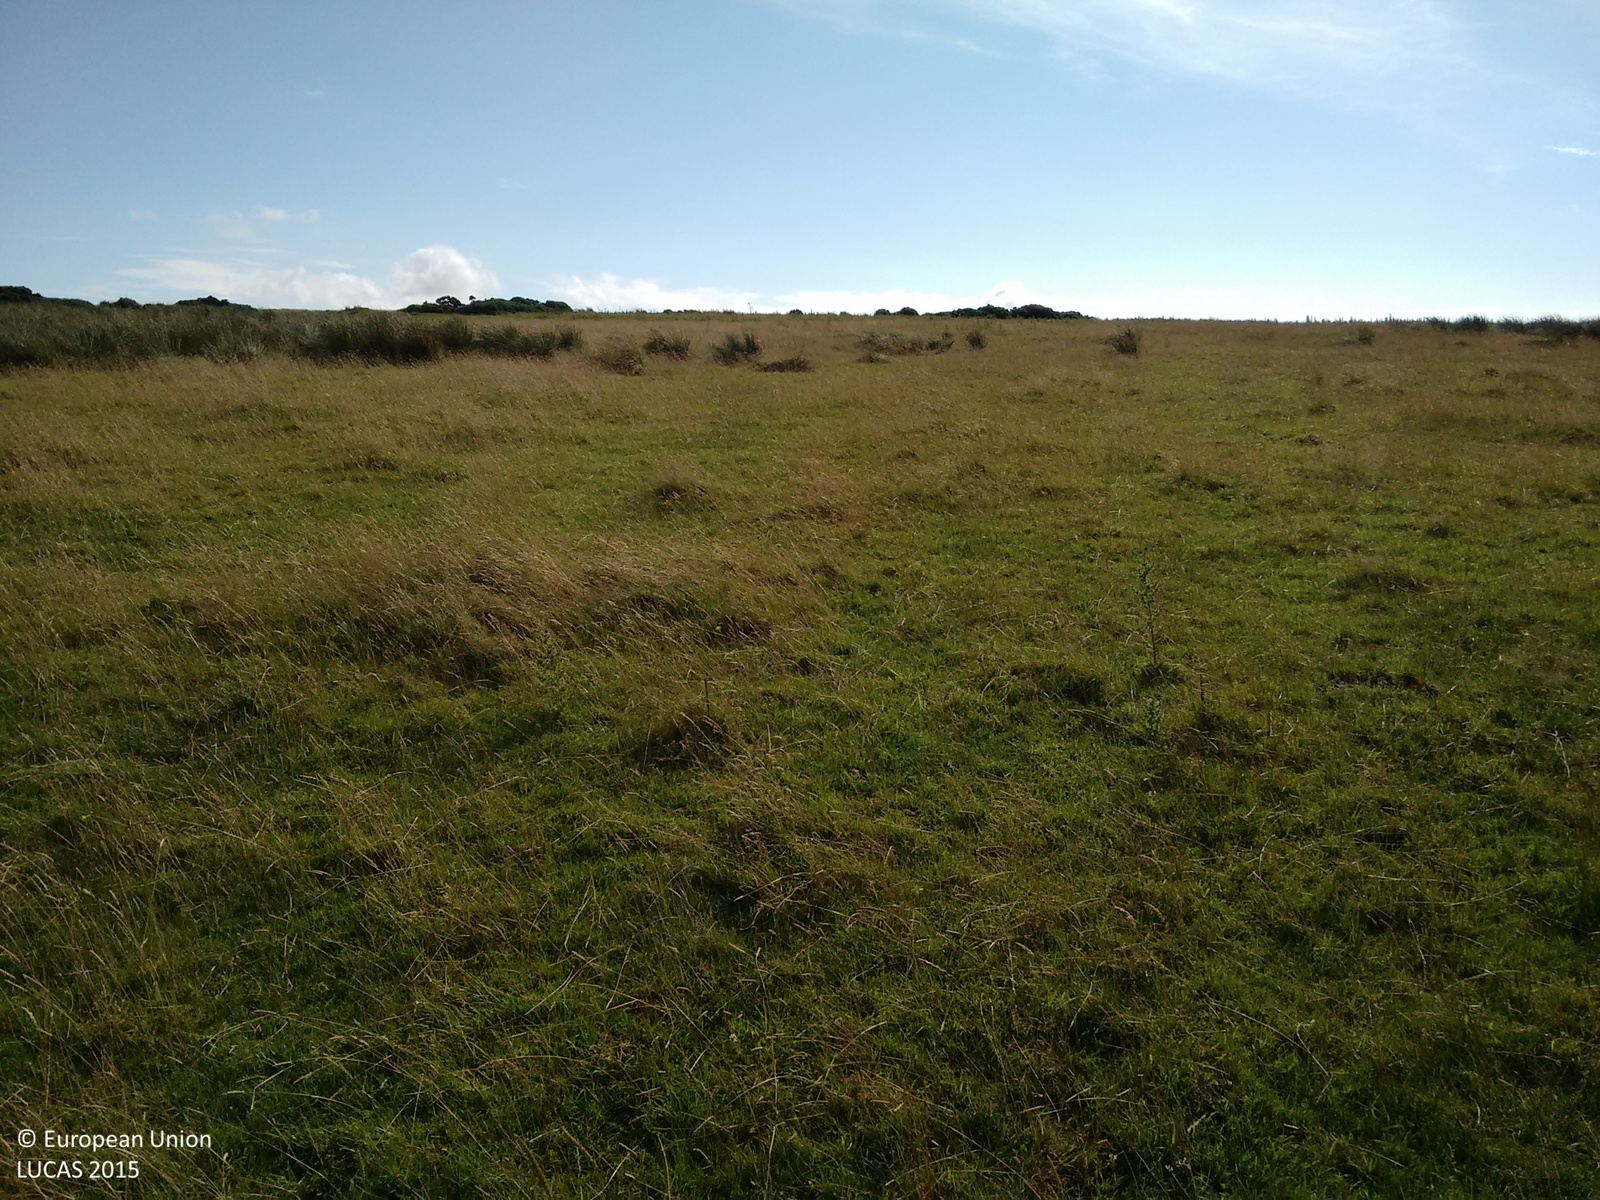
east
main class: Grassland
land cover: Grassland without tree/shrub cover
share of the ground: > 75 %
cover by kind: herbaceous plants 100 %
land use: Agriculture (excluding fallow land and kitchen gardens)
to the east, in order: Grassland without tree/shrub cover; Shrubland without tree cover; Ditches and canals; Grassland without tree/shrub cover
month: August
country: GB
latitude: 57.6551
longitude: -2.2651
